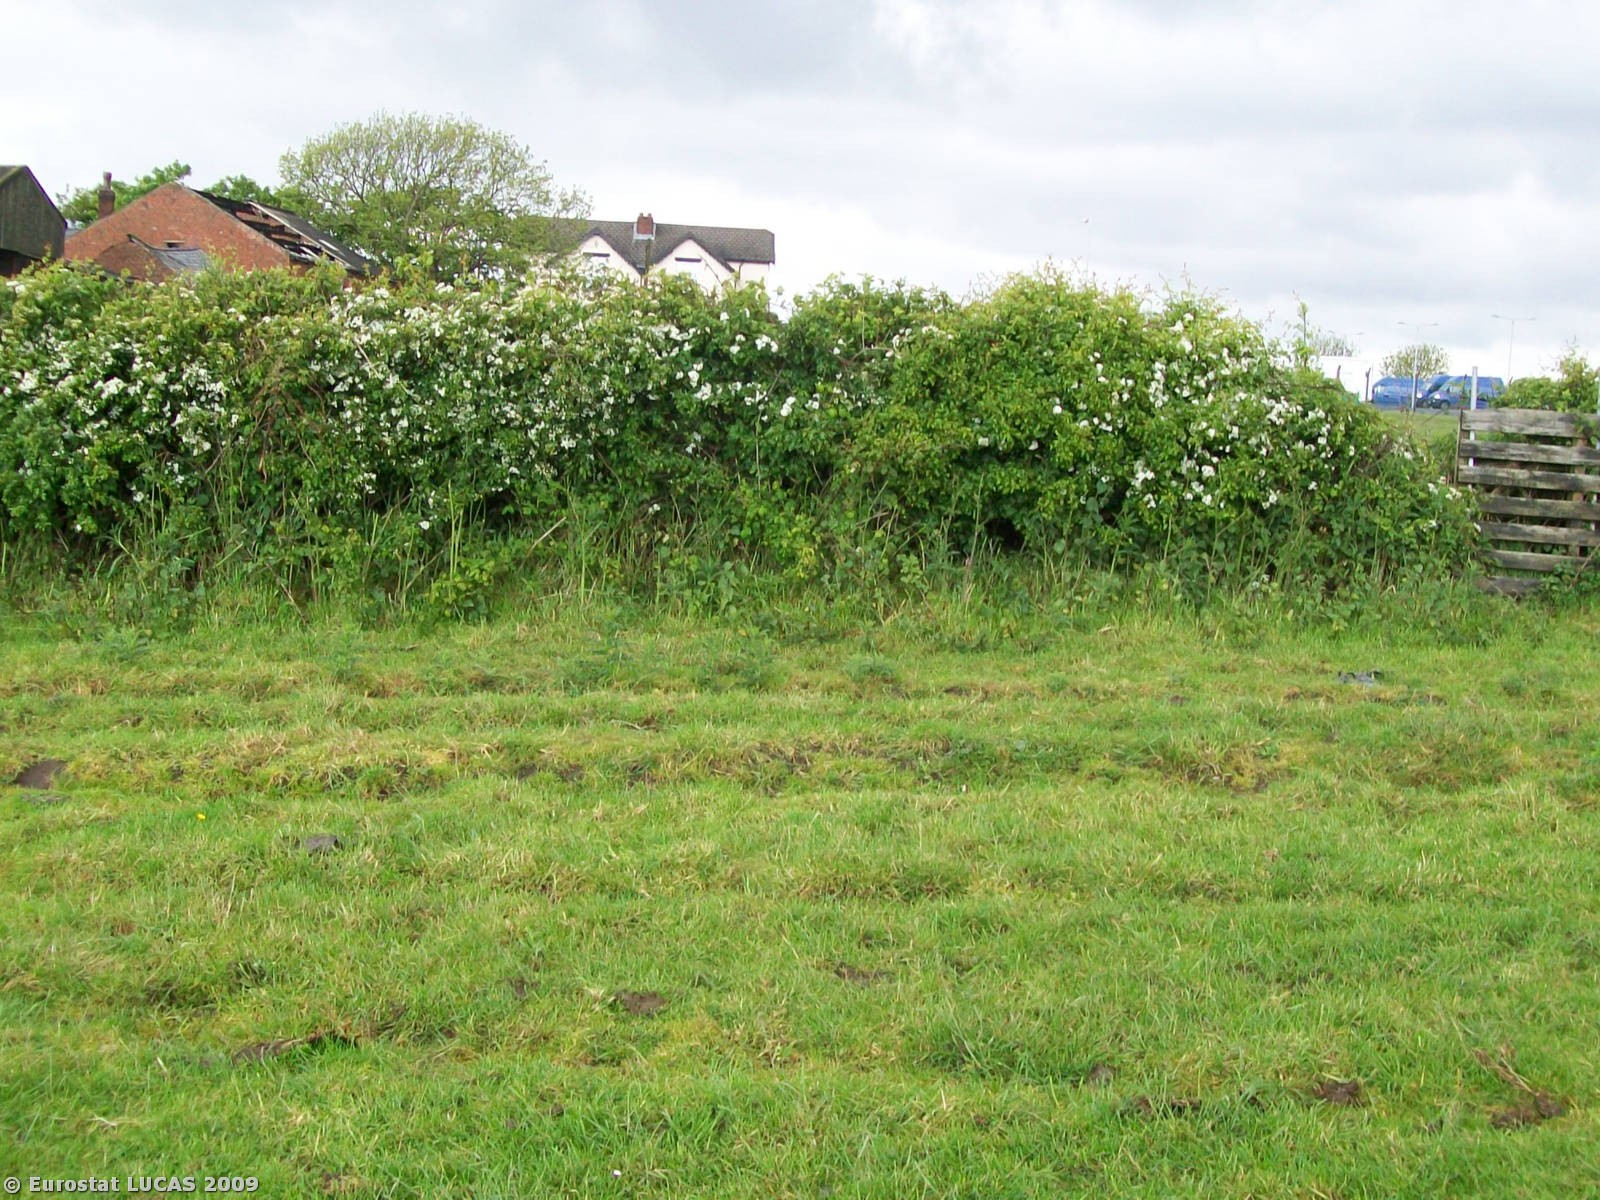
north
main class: Grassland
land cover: Grassland without tree/shrub cover
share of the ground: > 75 %
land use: Agriculture (excluding fallow land and kitchen gardens)
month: May
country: GB
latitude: 53.8622
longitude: -3.0137
